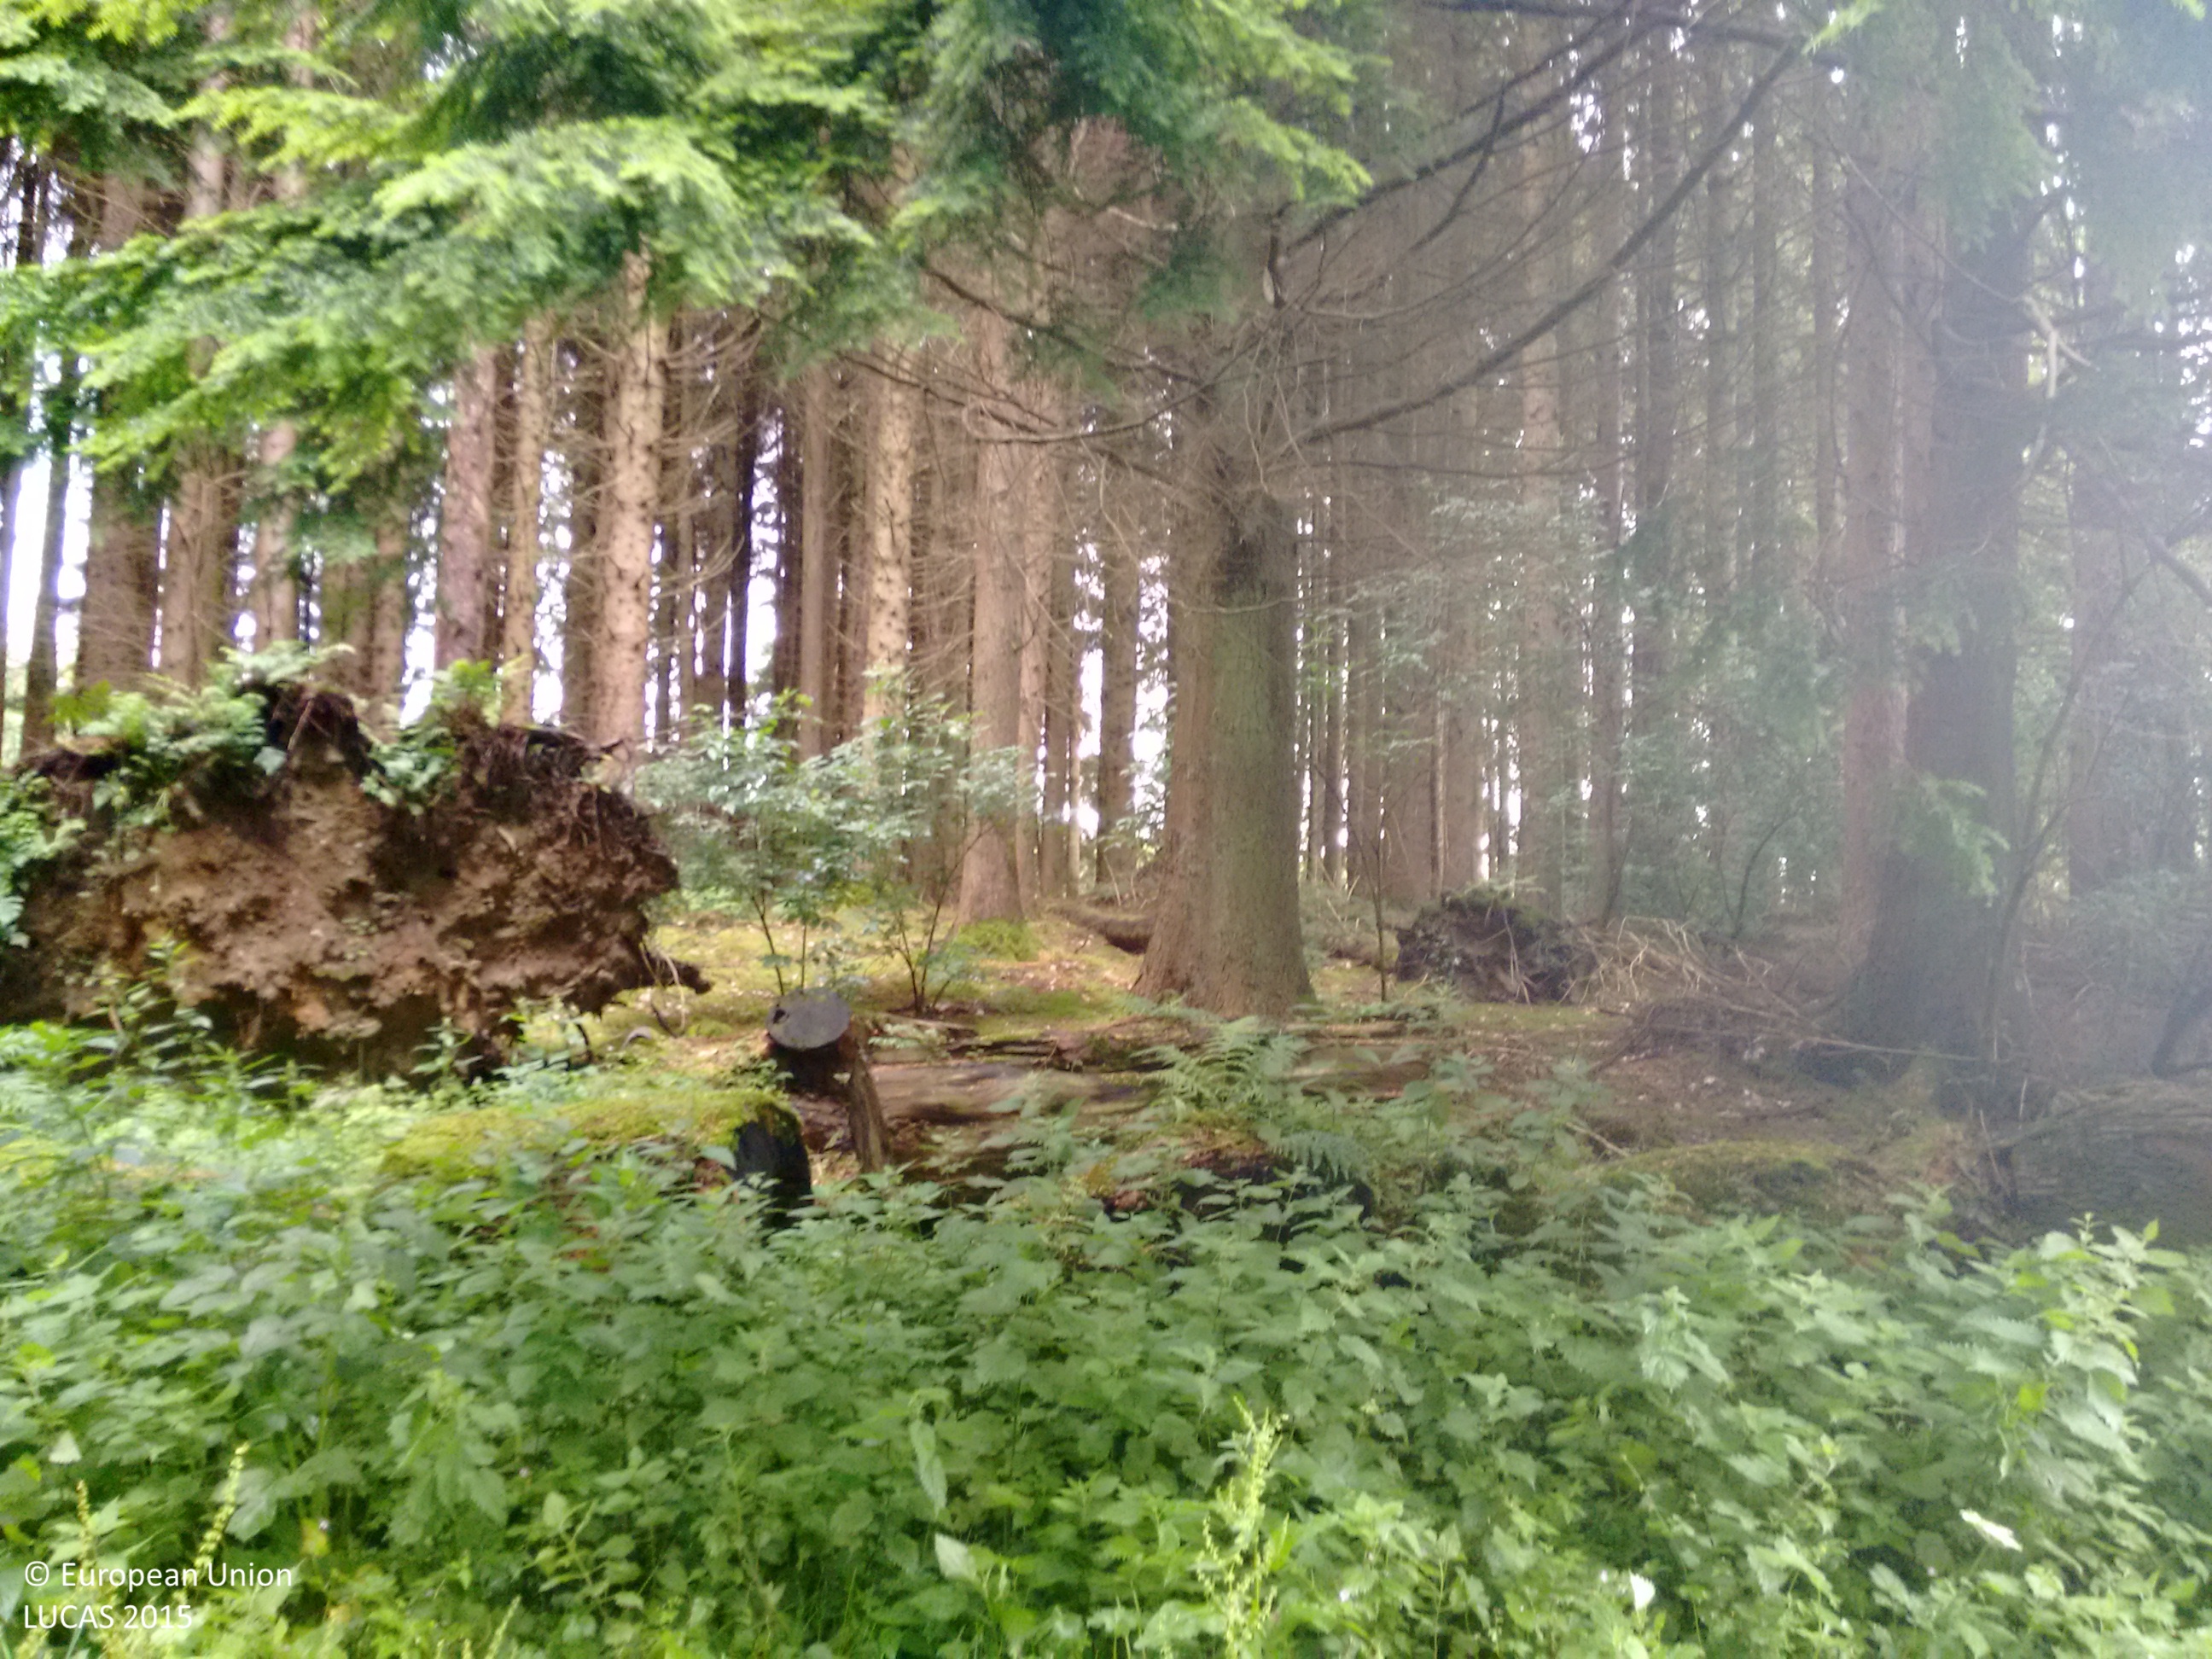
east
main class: Woodland
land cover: Spruce dominated coniferous woodland
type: exotic forest
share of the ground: > 75 %
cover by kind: coniferous forest trees 100 %
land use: Forestry
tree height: > 5 m
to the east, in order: Spruce dominated coniferous woodland; Fences; Grassland without tree/shrub cover; Fences; Grass margins; Rivers and streams; Grass margins; Spruce dominated mixed woodland; Grassland without tree/shrub cover; Fences; Grassland without tree/shrub cover; Fences; Grass margins; Paved roads, cycling and walking lanes; Grass margins; Single bushes/trees; Grass margins; Fences; Grassland without tree/shrub cover
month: July
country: GB
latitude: 54.4090
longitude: -7.2975
